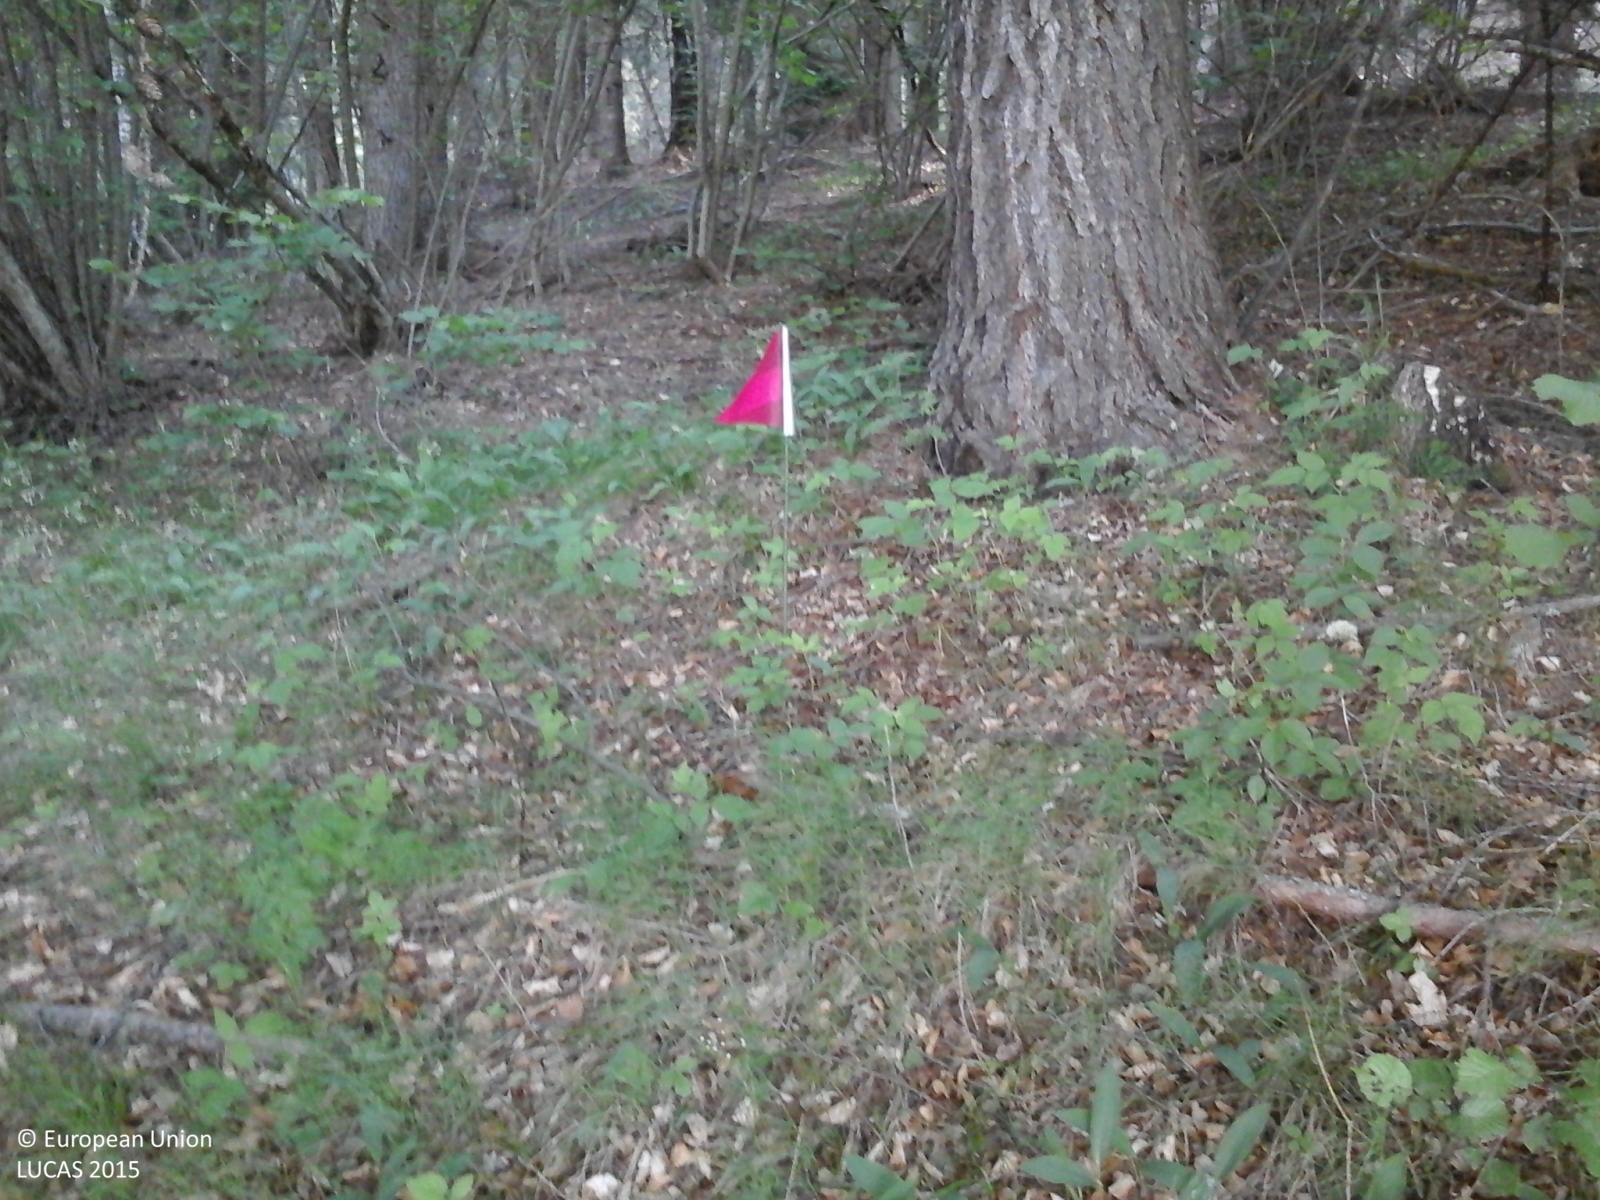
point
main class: Woodland
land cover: Spruce dominated mixed woodland
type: alpine coniferous forest
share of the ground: > 75 %
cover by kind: coniferous forest trees 70 %, broadleaved forest trees 30 %
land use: Forestry
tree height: > 5 m
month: June
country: IT
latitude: 46.7763
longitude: 11.2428
